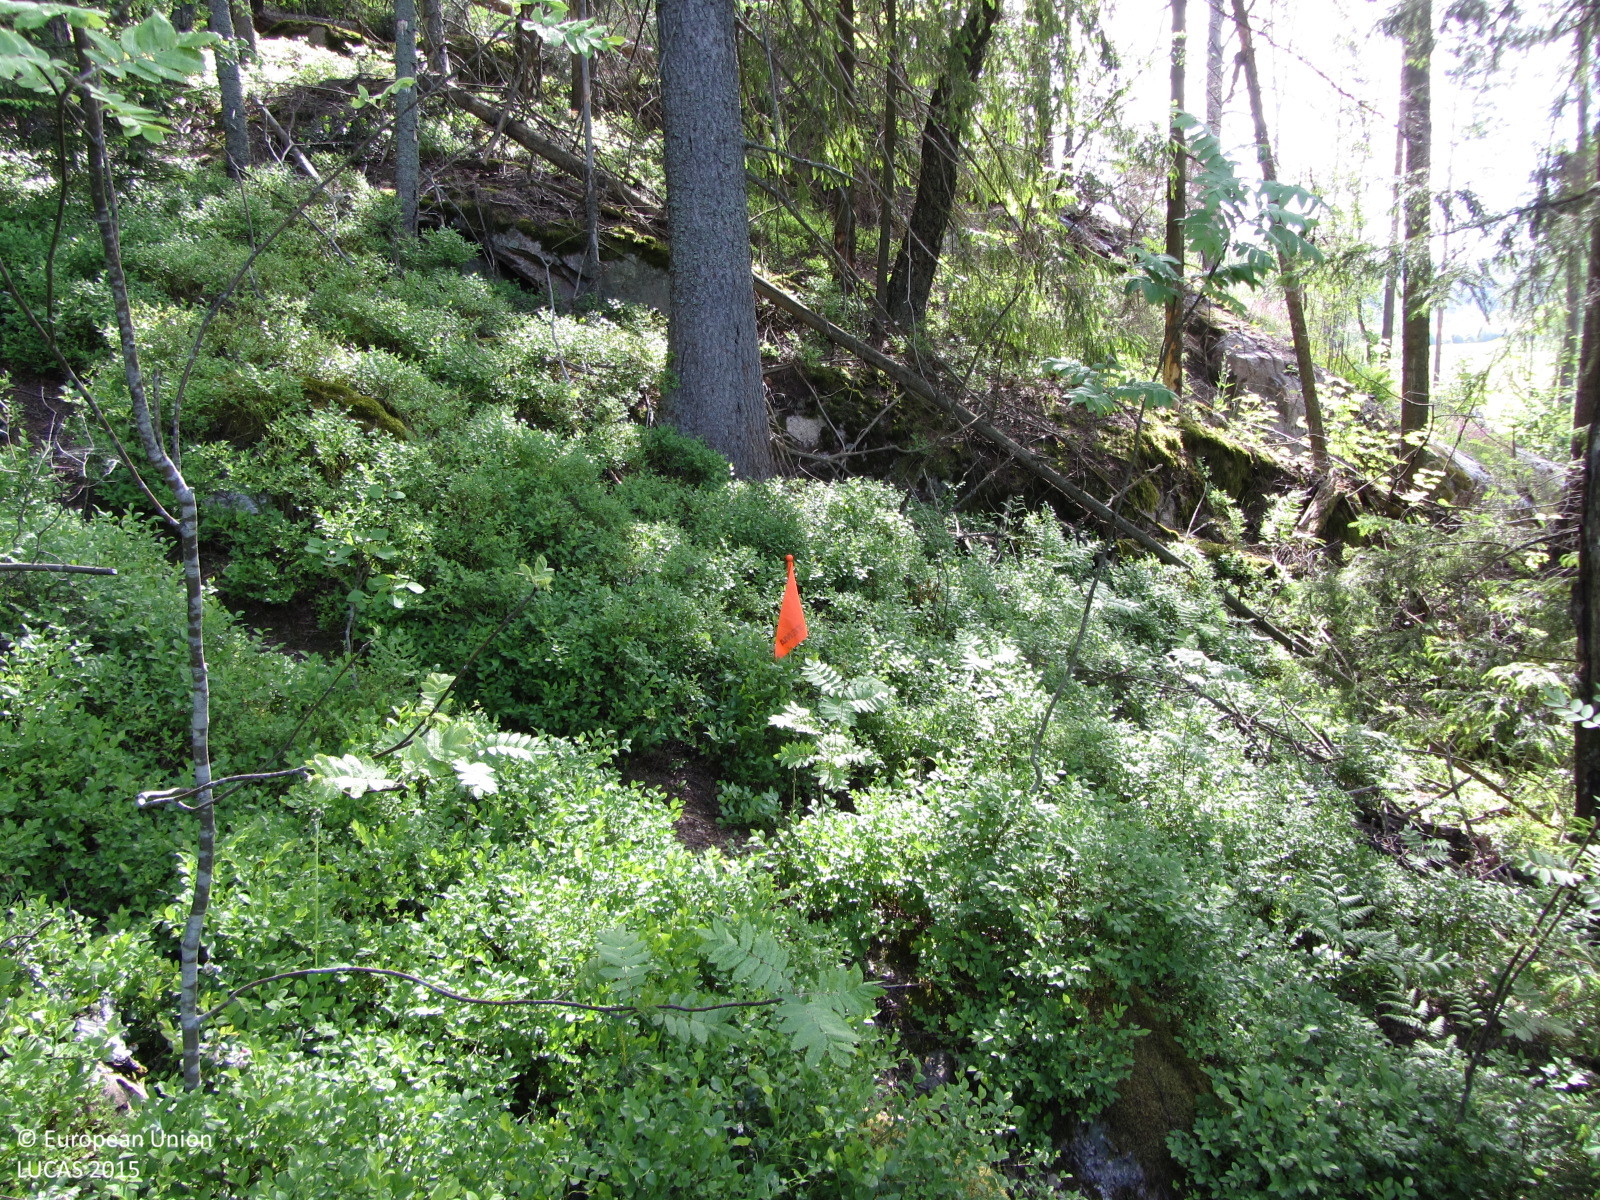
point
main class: Woodland
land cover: Spruce dominated mixed woodland
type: boreal forest
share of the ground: > 75 %
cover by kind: broadleaved forest trees 45 %, coniferous forest trees 40 %, shrubs 10 %, herbaceous plants 5 %
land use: Forestry
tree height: > 5 m
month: June
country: FI
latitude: 60.1707
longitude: 24.2148
